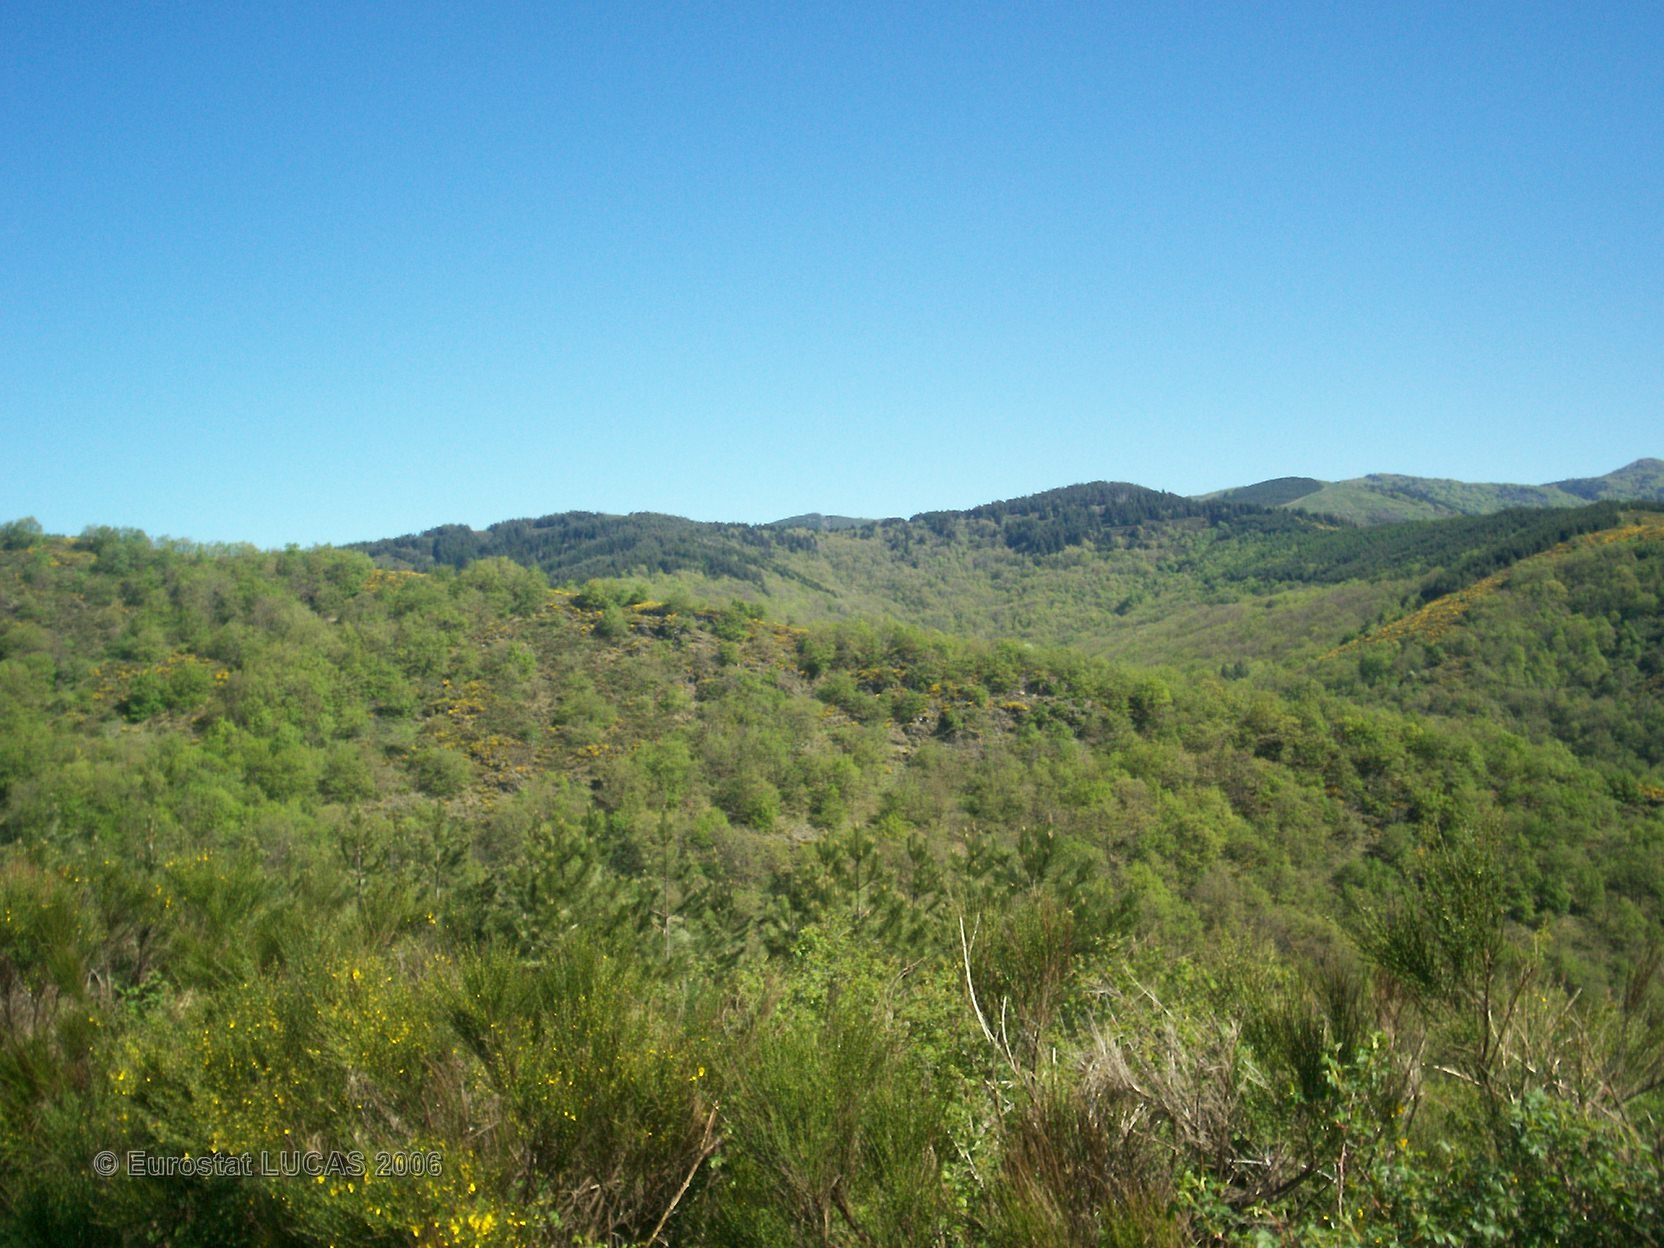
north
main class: Grassland
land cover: Grassland without tree/shrub cover
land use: Agriculture (excluding fallow land and kitchen gardens)
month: May
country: FR
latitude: 43.9799
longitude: 3.4372
